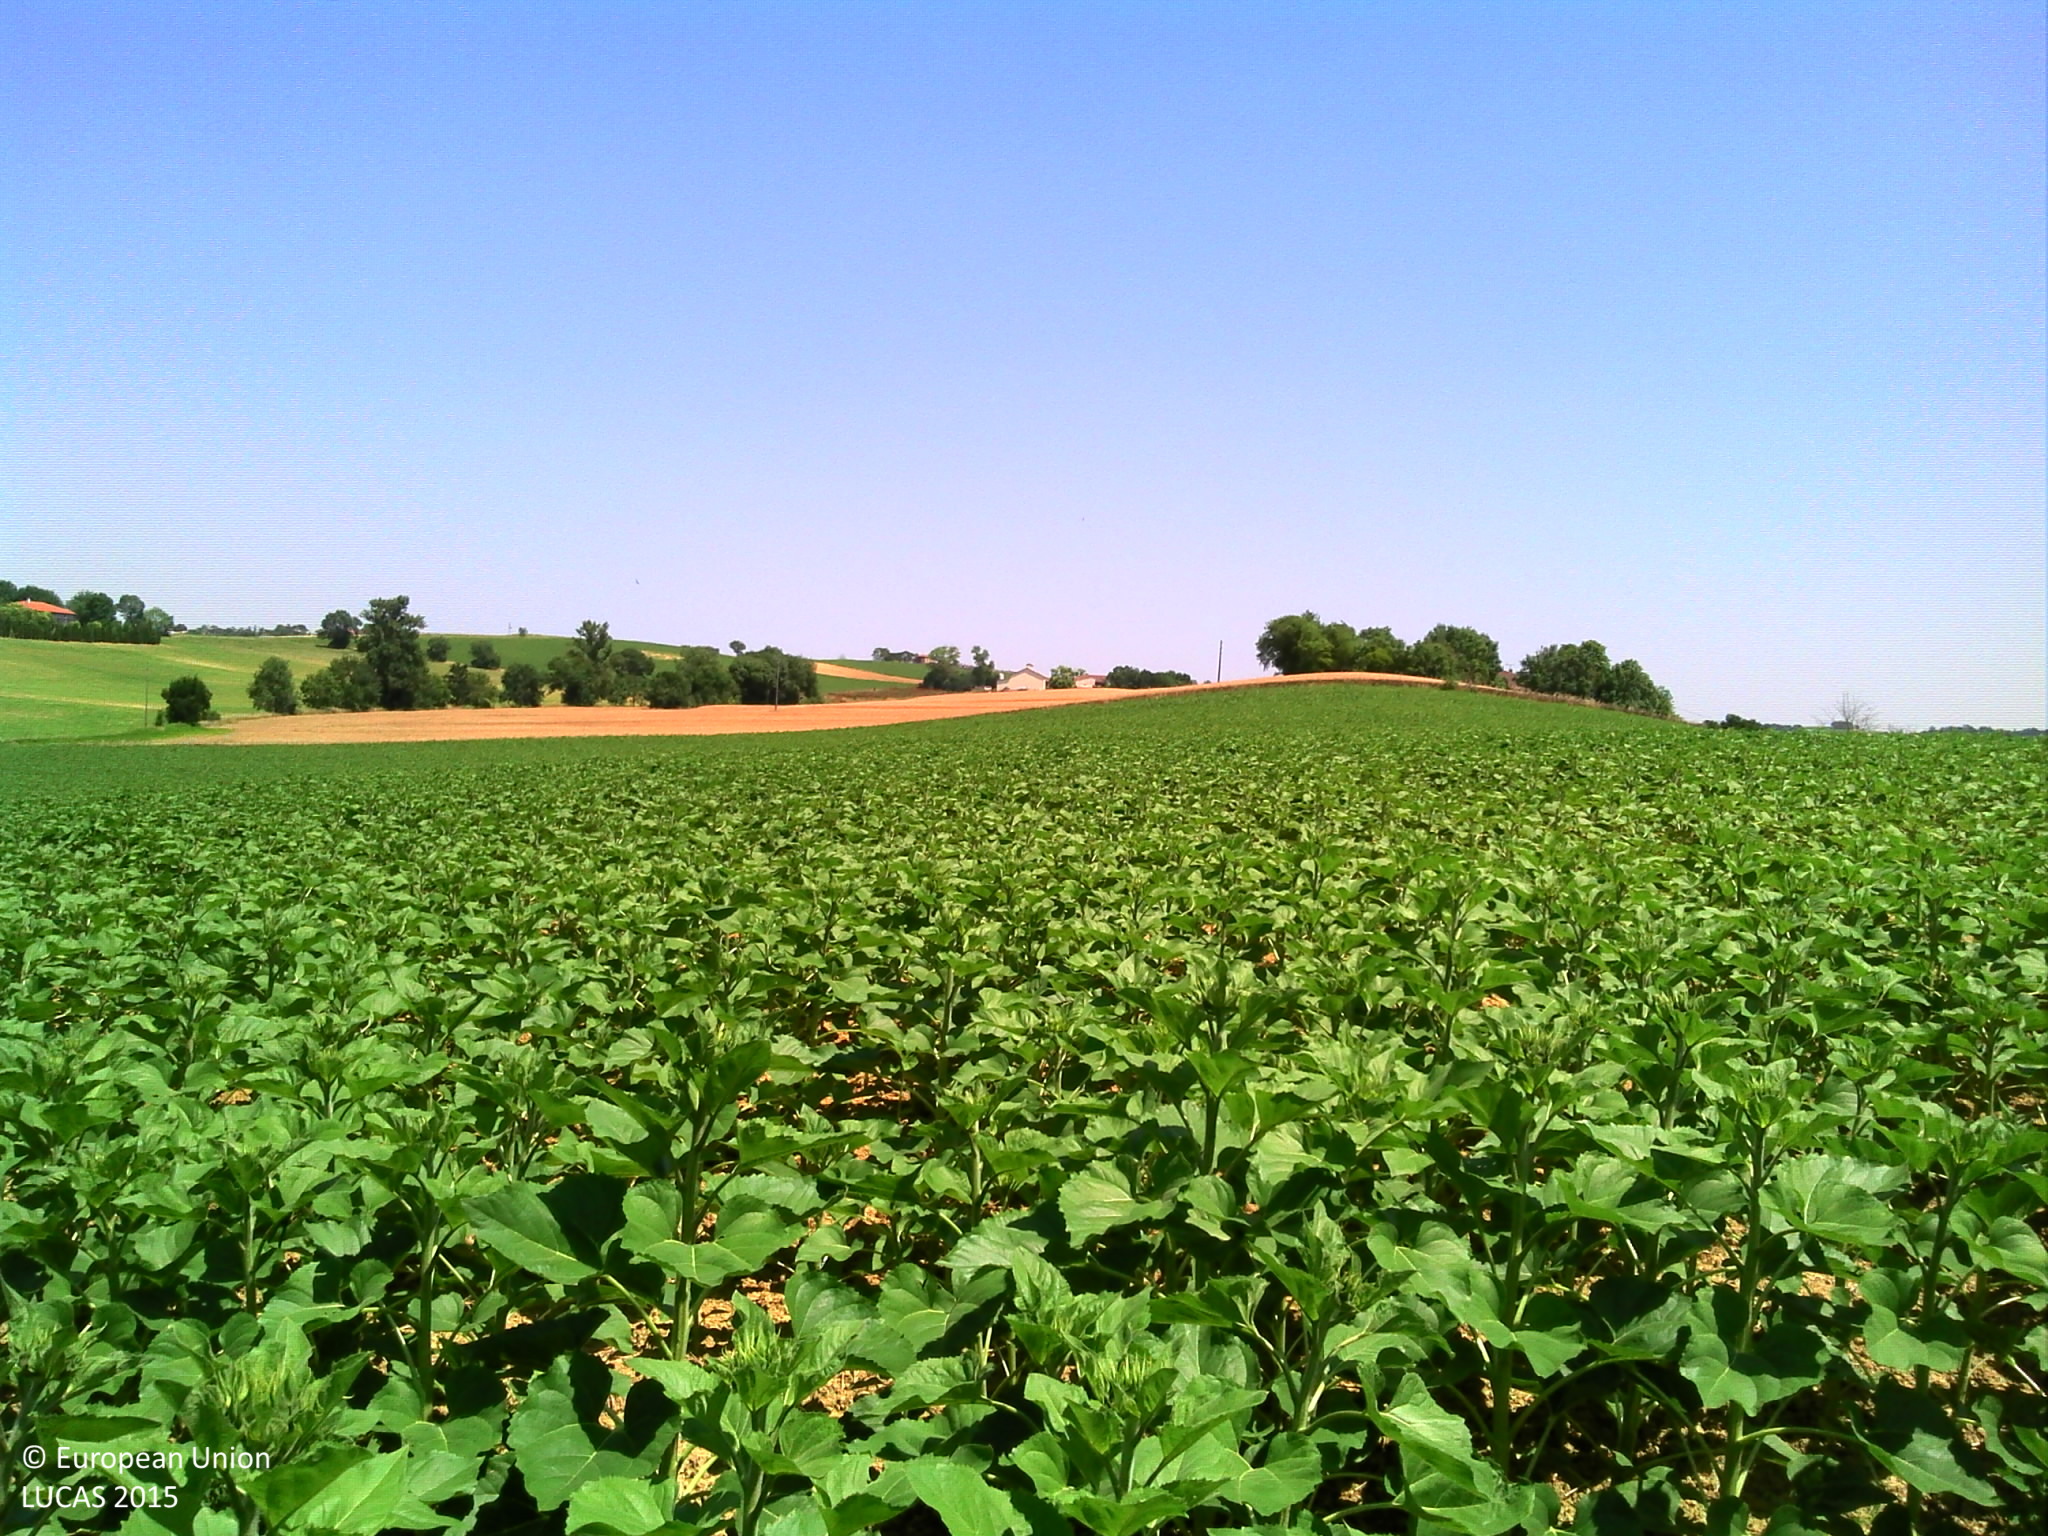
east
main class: Cropland
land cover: Sunflower
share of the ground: > 75 %
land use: Agriculture (excluding fallow land and kitchen gardens)
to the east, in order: Sunflower; Grass margins; Common wheat
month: June
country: FR
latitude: 43.7251
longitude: 1.0247
